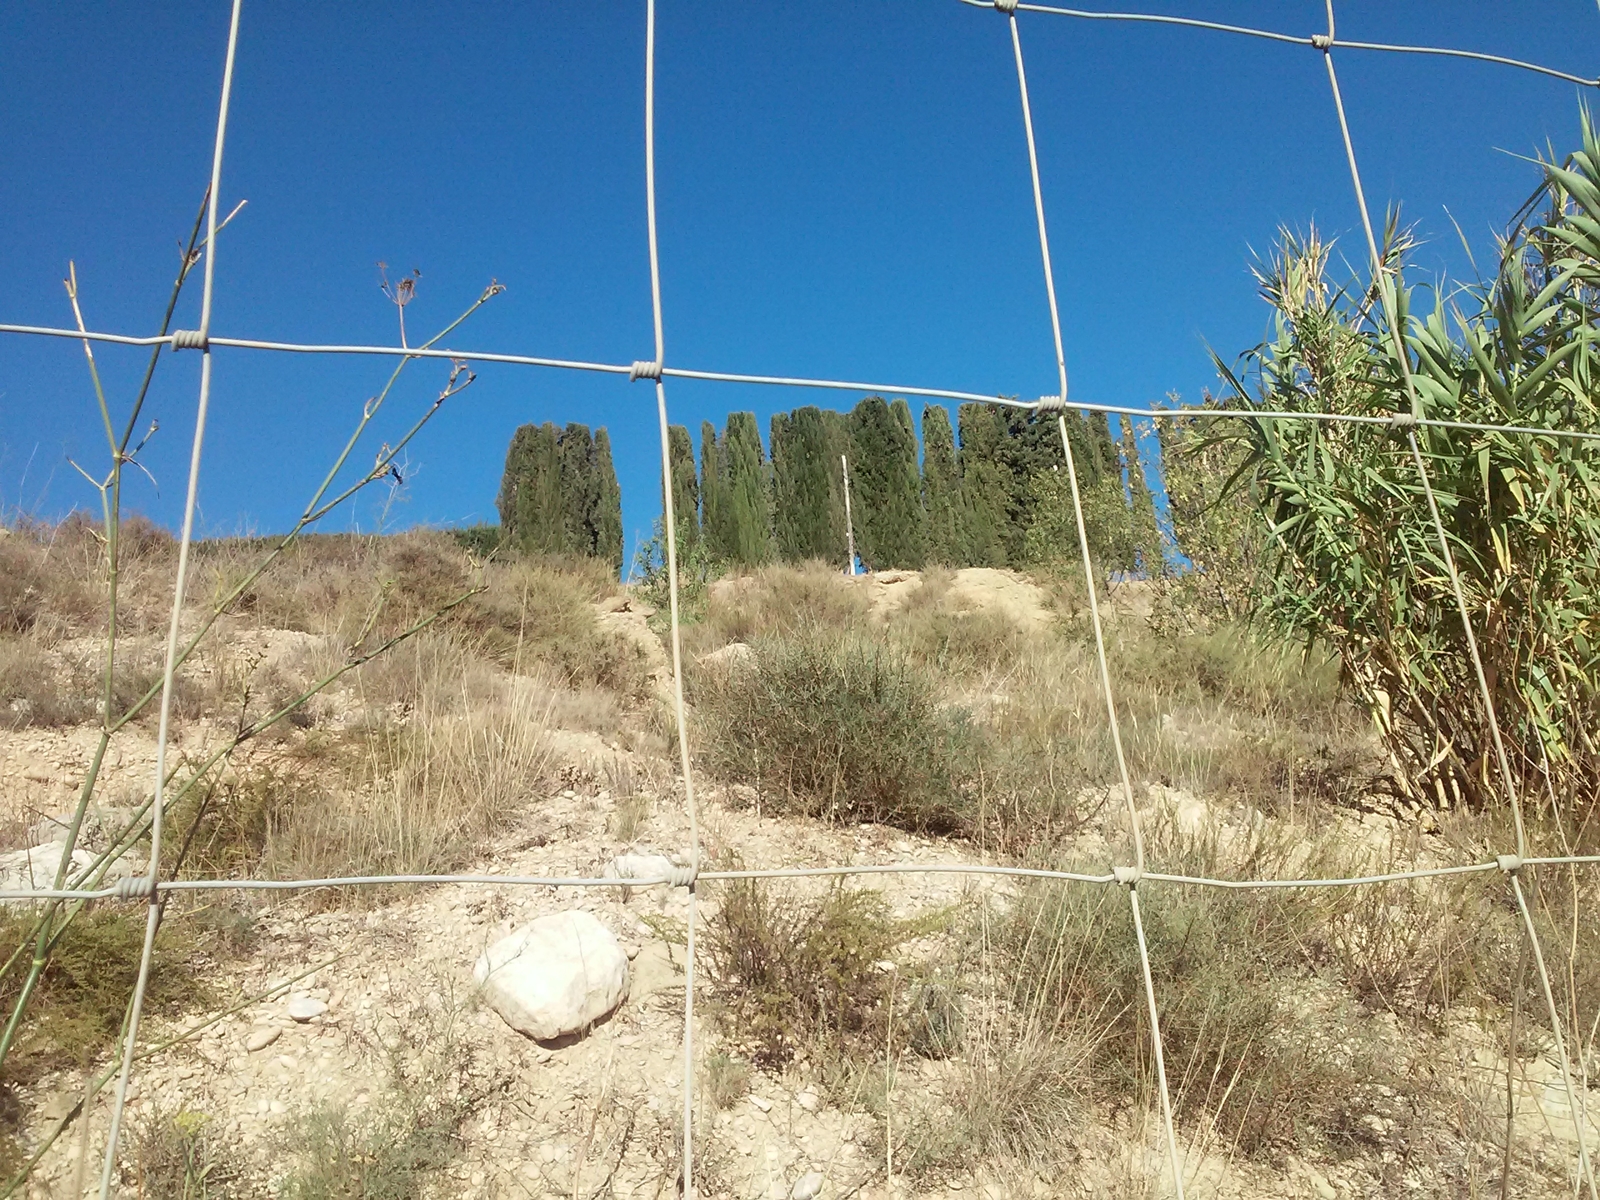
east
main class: Grassland
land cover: Grassland without tree/shrub cover
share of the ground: 50 - 75 %
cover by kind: herbaceous plants 75 %, consolidated bare surface 20 %, shrubs 5 %
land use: Semi-natural and natural areas not in use
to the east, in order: Grassland without tree/shrub cover; Abandoned hedges; Artificial constructions in urban areas; Abandoned hedges; Other bare soil; Artificial constructions in urban areas
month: September
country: ES
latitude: 41.5594
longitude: 0.5754
